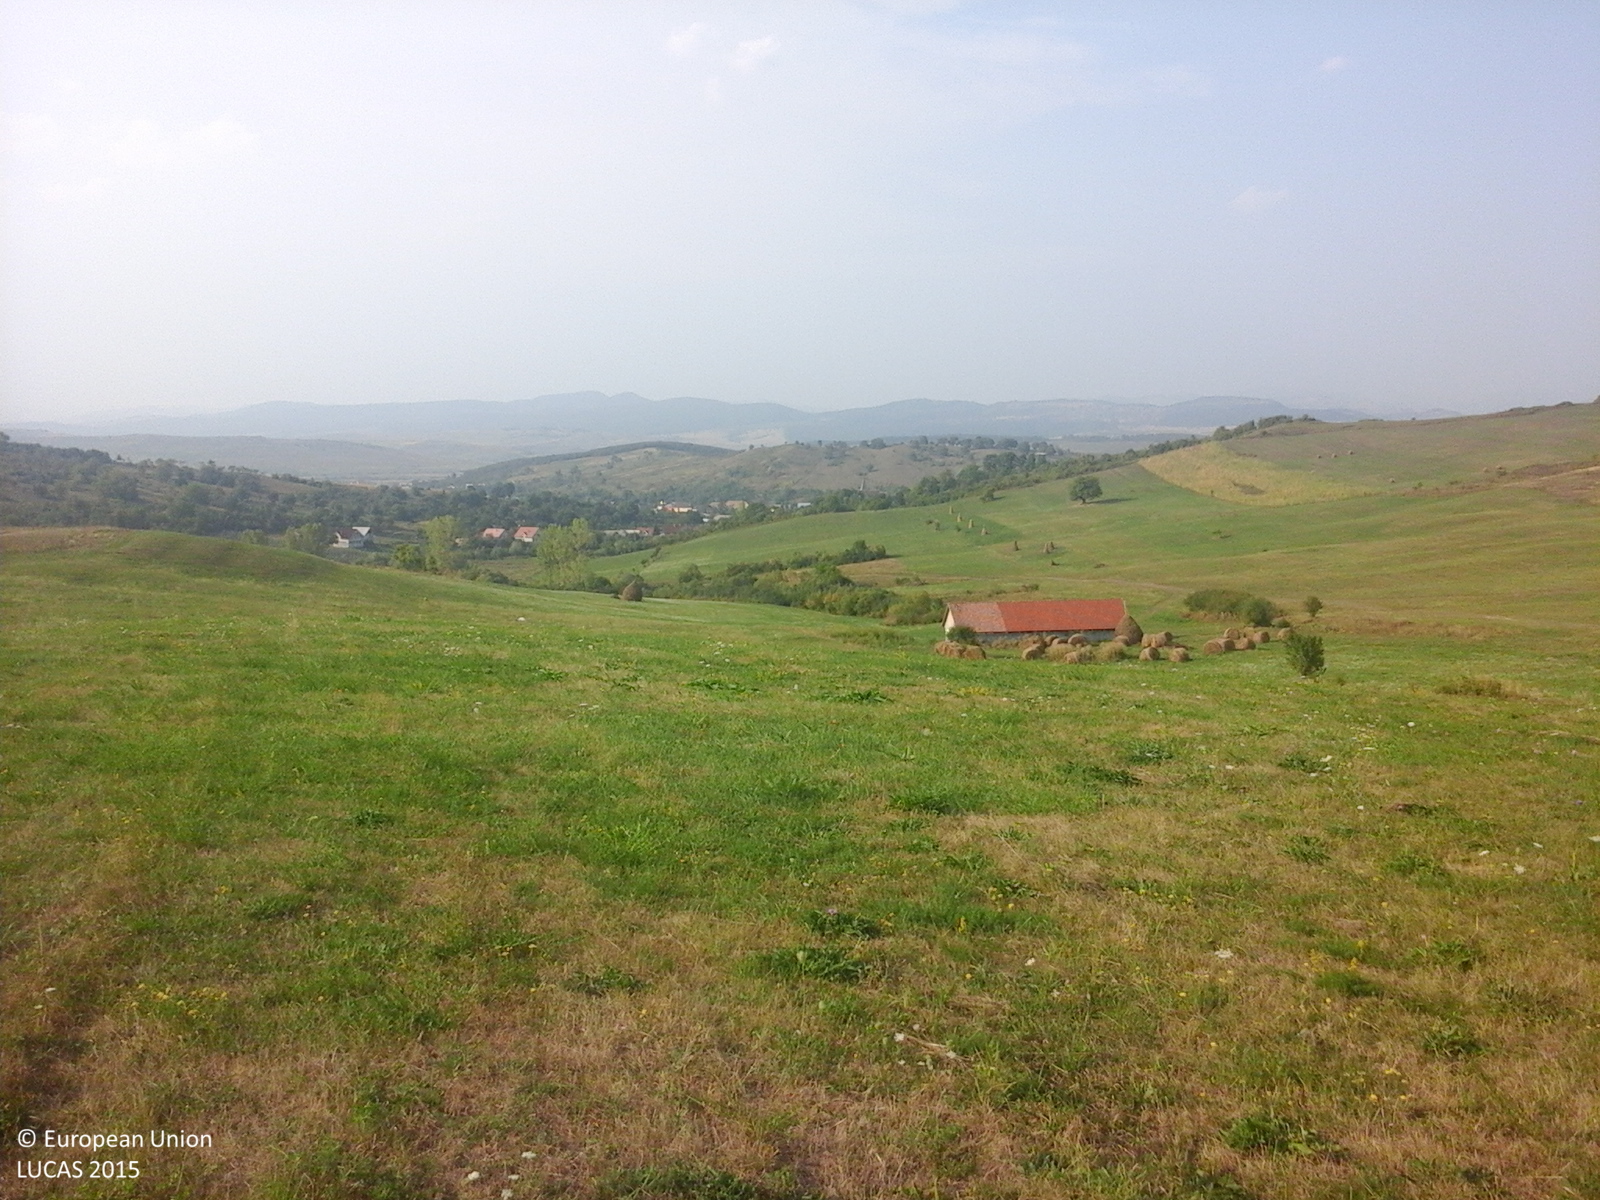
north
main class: Grassland
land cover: Grassland without tree/shrub cover
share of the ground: > 75 %
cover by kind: herbaceous plants 100 %
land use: Agriculture (excluding fallow land and kitchen gardens)
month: September
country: RO
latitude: 47.1796
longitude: 24.4063
